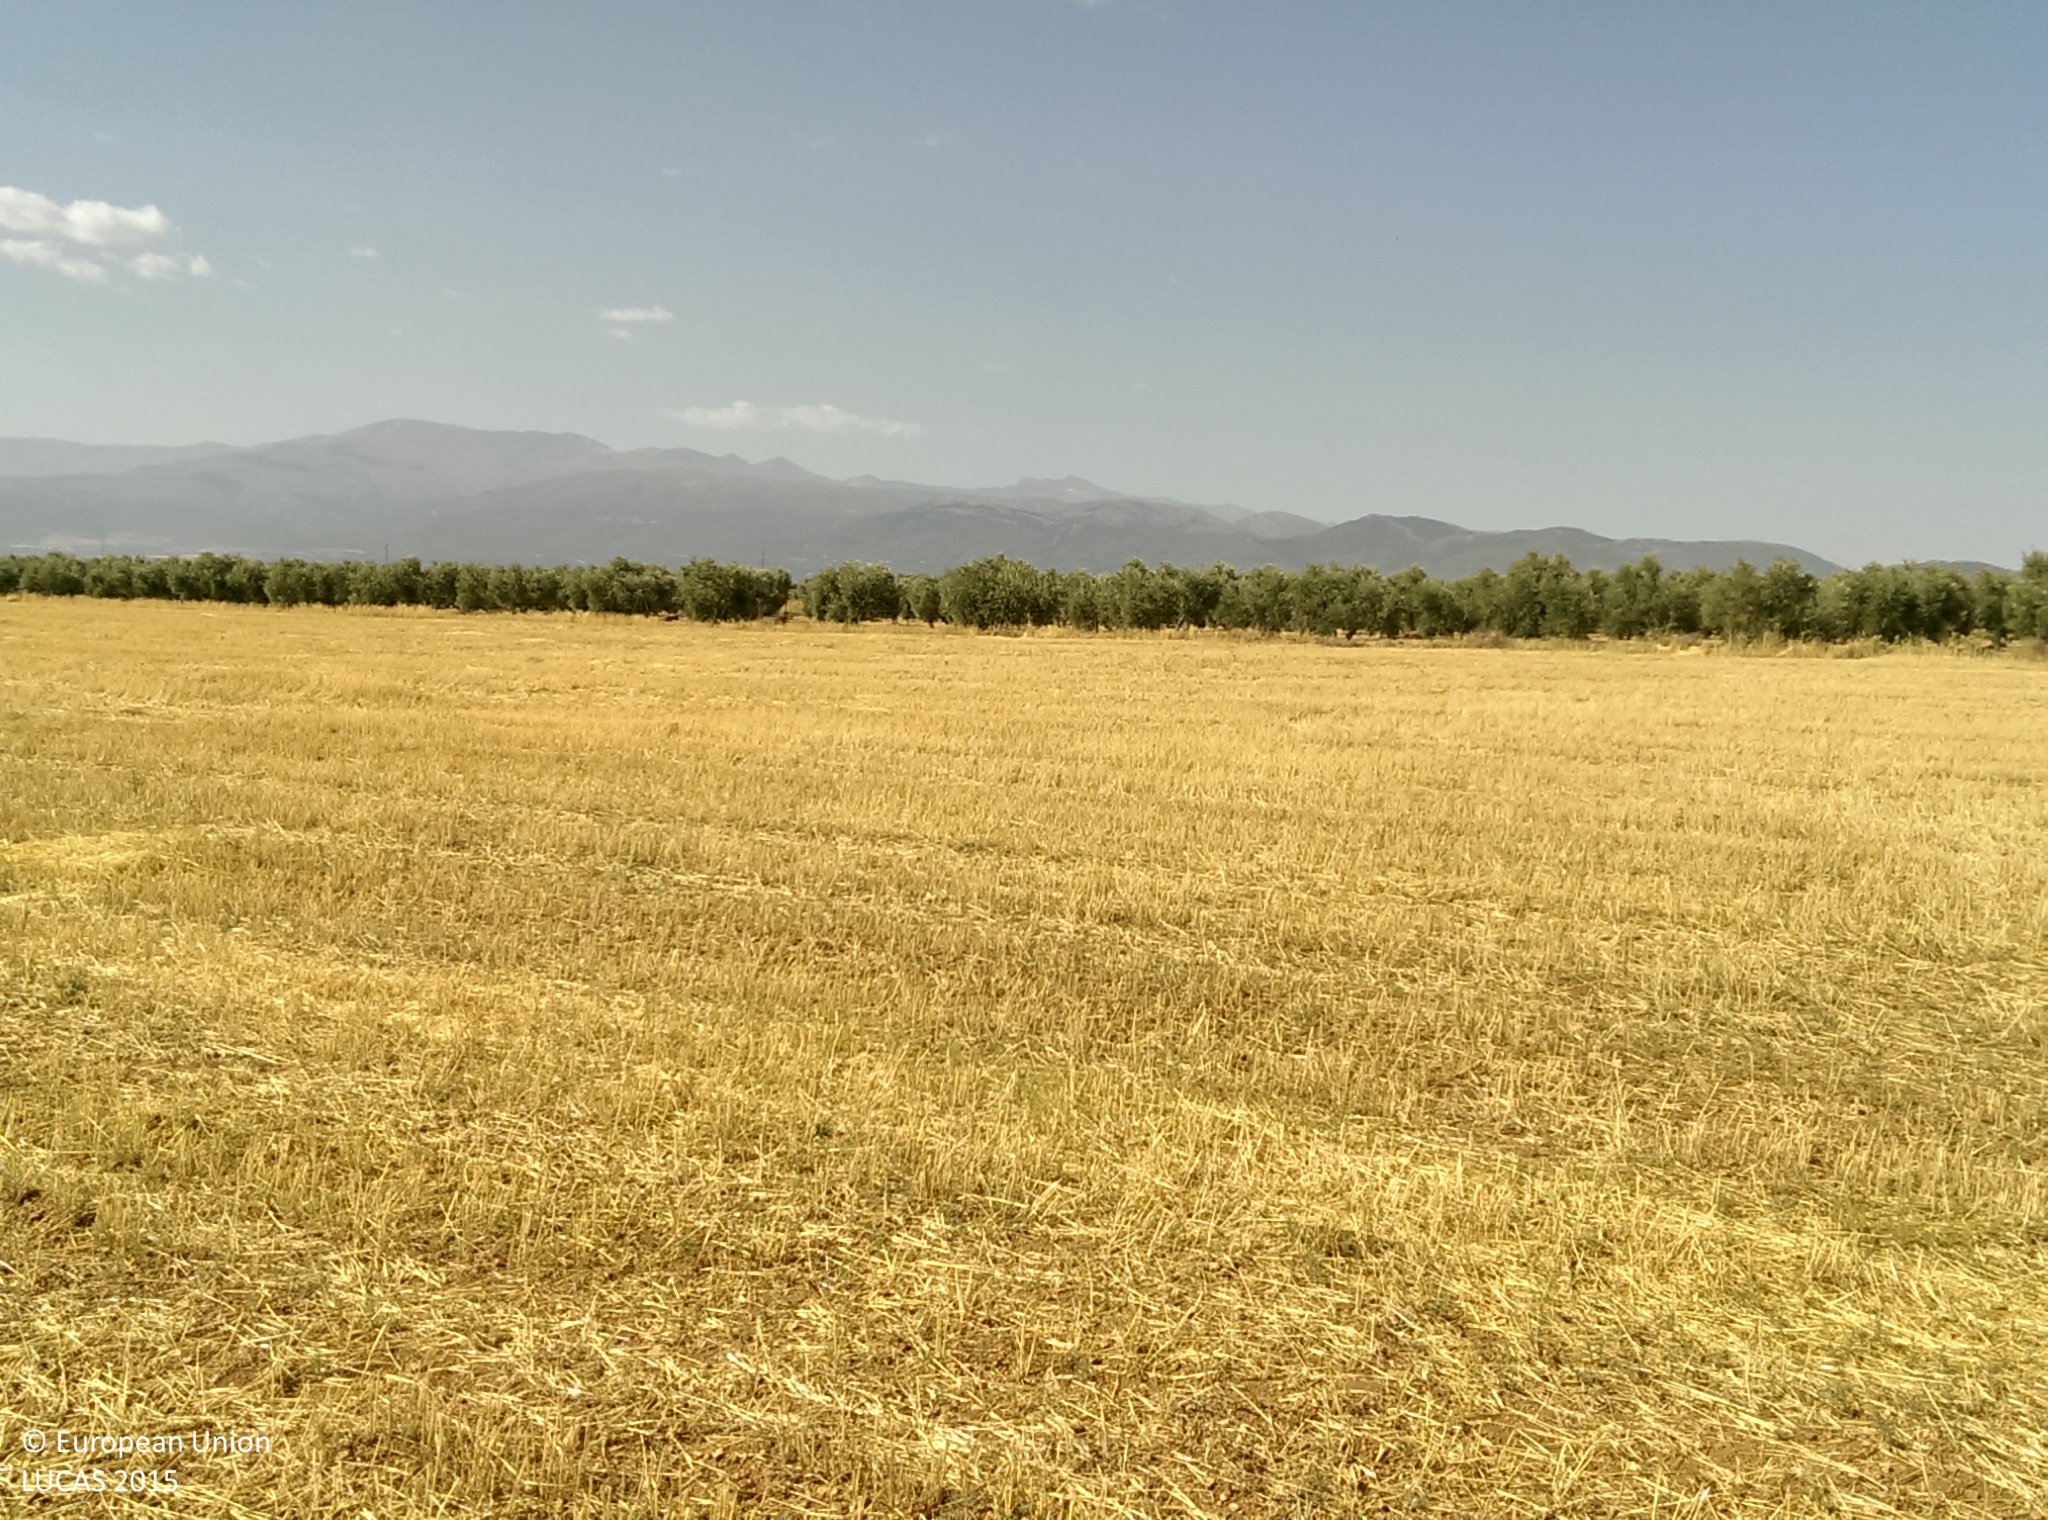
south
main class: Cropland
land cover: Barley
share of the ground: < 10 %
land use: Agriculture (excluding fallow land and kitchen gardens)
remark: Harvested field
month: July
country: ES
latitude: 37.3446
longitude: -3.2751
